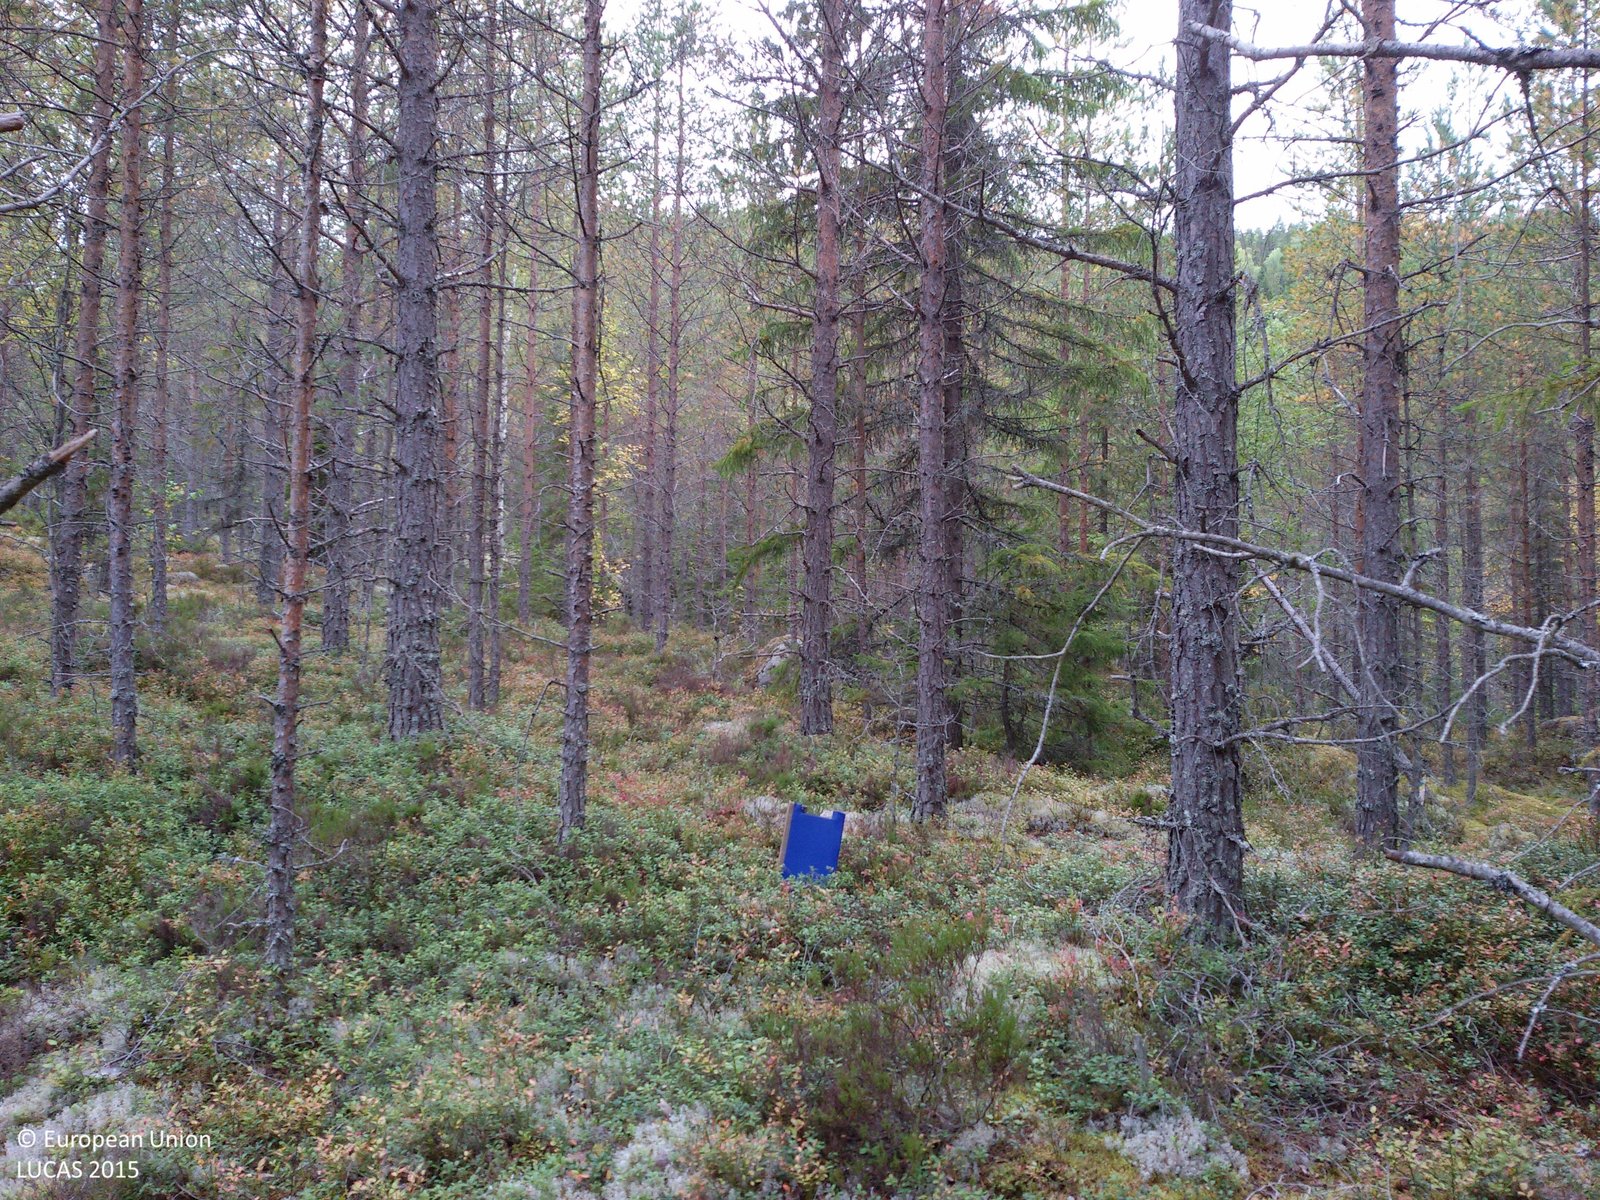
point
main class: Woodland
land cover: Pine dominated coniferous woodland
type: boreal forest
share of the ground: > 75 %
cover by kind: coniferous forest trees 80 %, shrubs 10 %, lichens and mosses 10 %
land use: Forestry
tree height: > 5 m
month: September
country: SE
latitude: 60.7182
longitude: 14.6246
